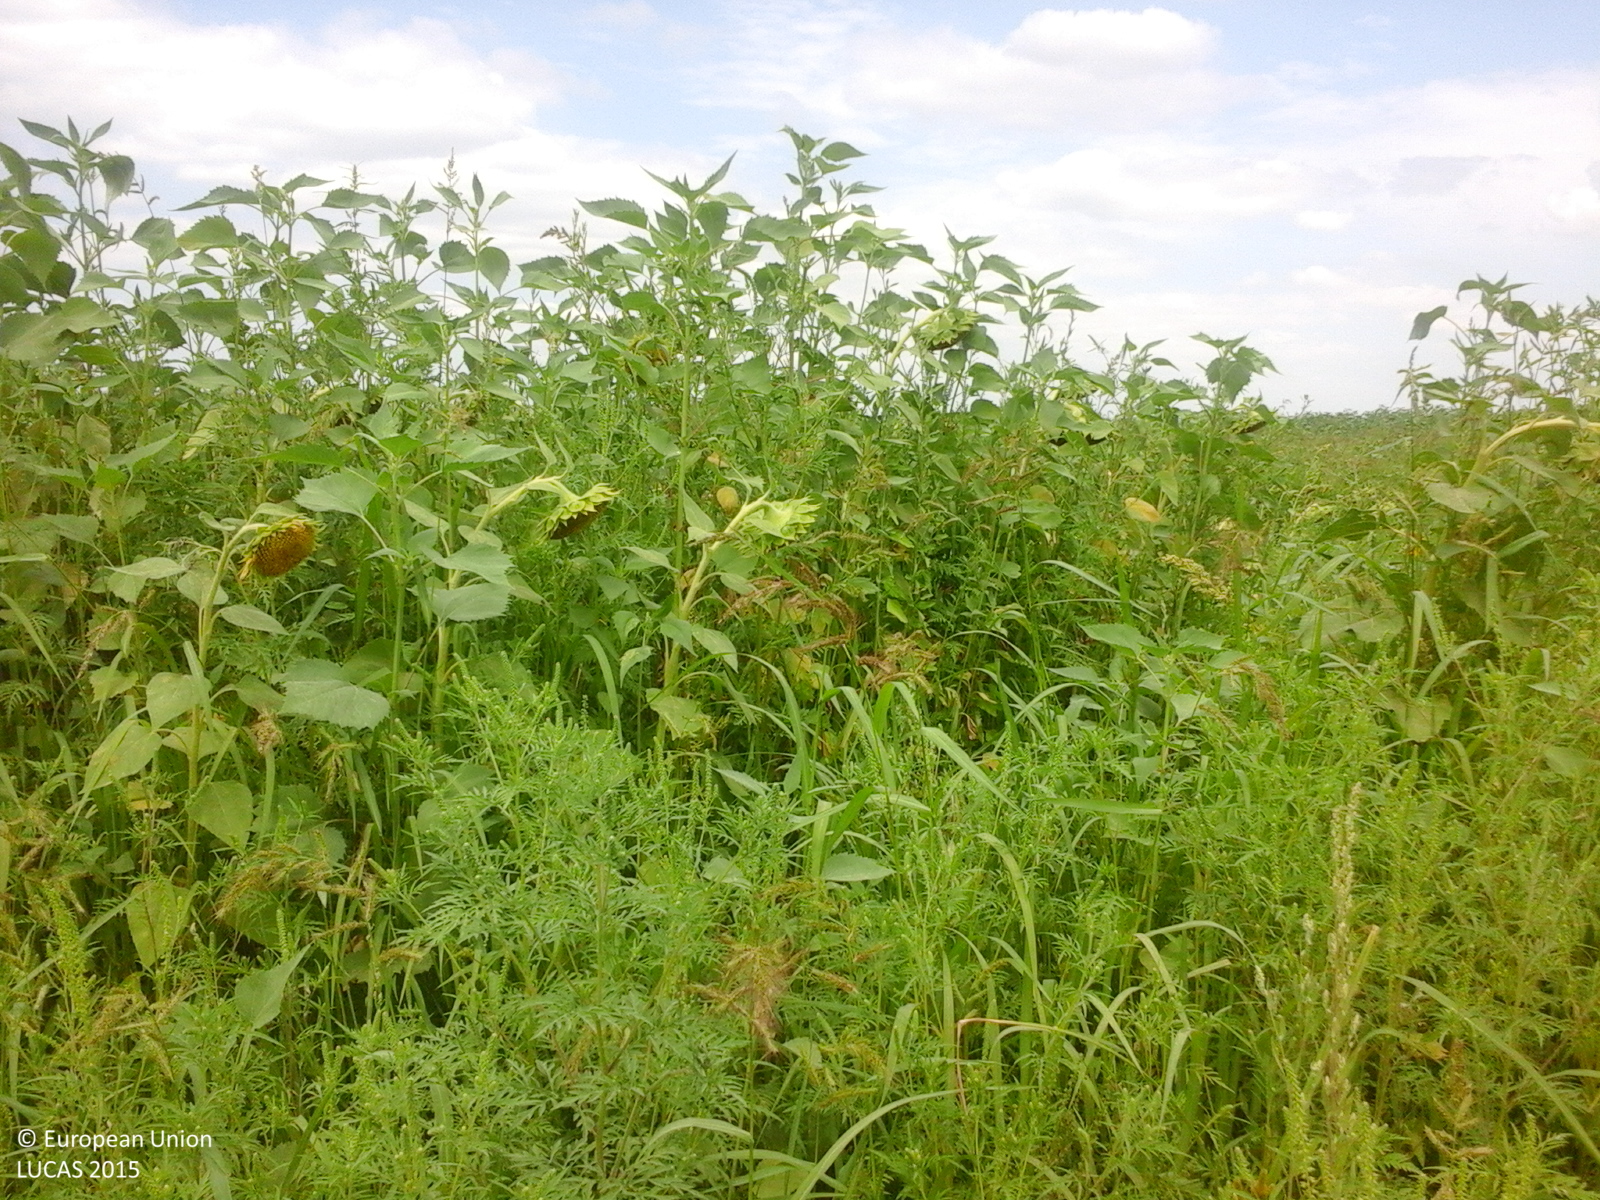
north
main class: Cropland
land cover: Sunflower
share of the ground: > 75 %
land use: Agriculture (excluding fallow land and kitchen gardens)
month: August
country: RO
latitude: 45.2779
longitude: 29.0820
